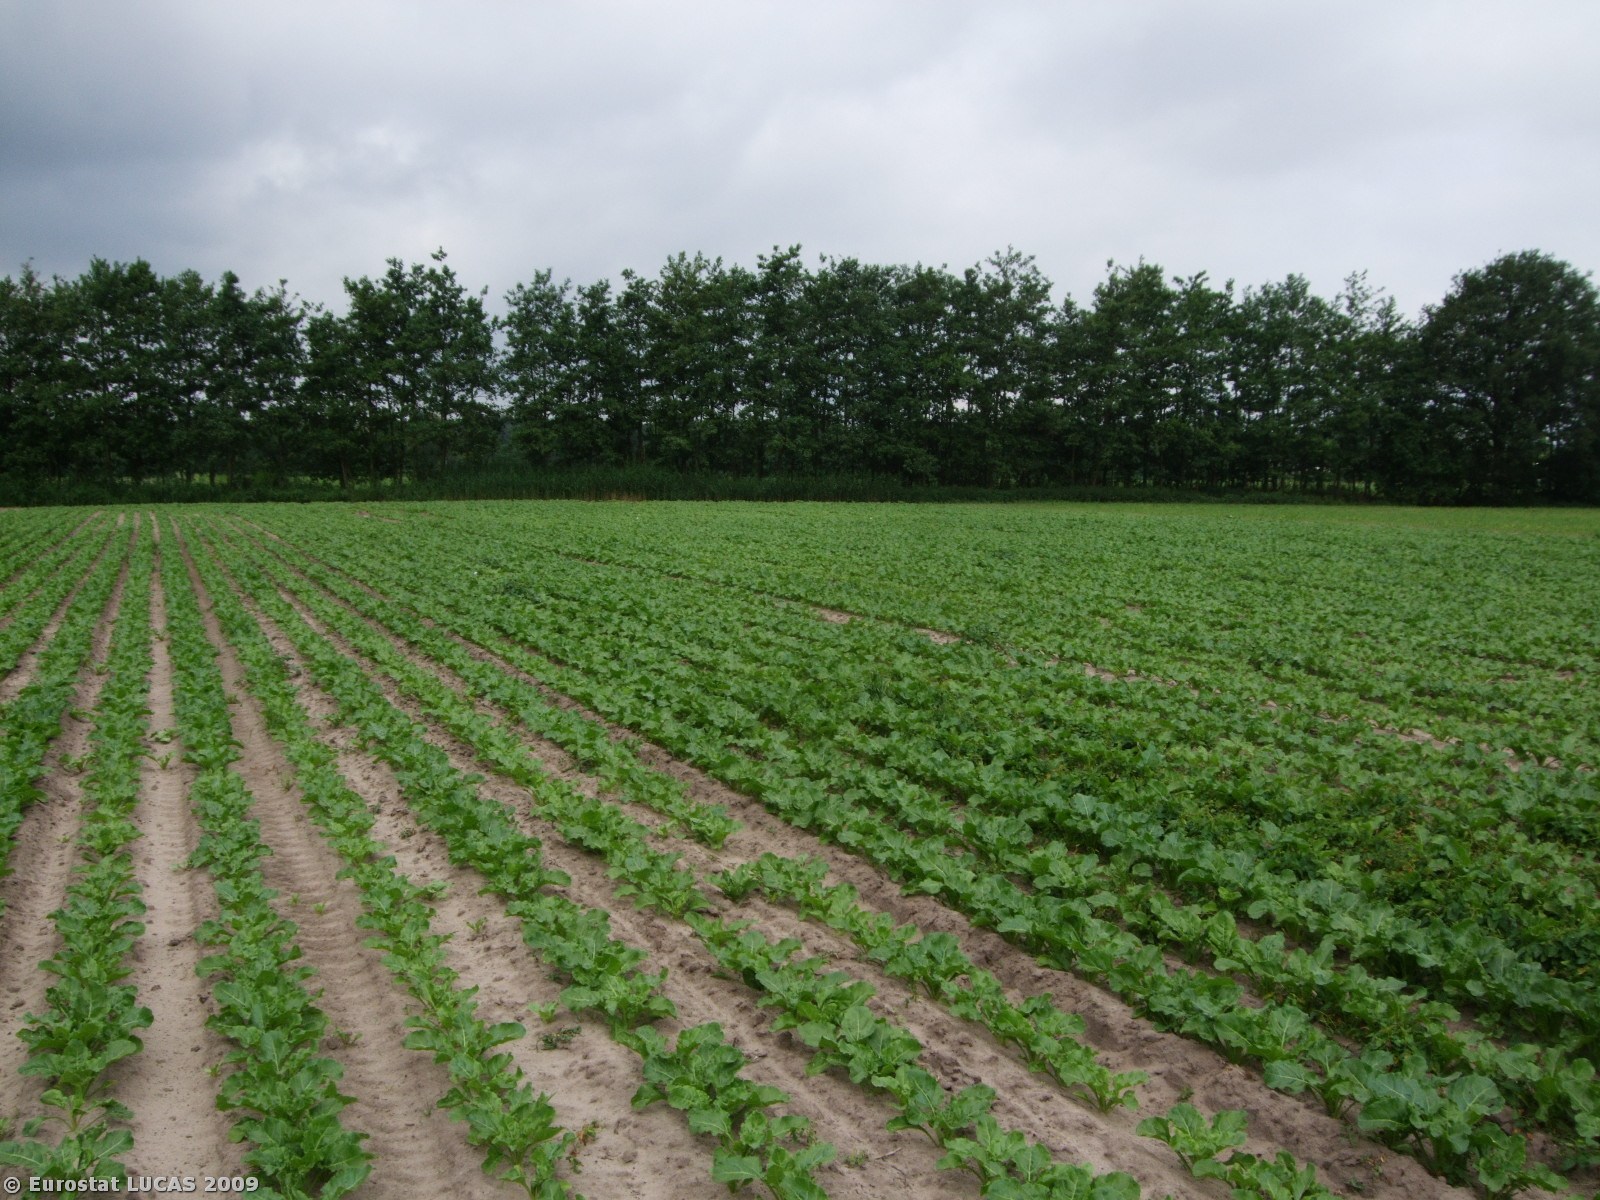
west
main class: Cropland
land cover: Sugar beet
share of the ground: 50 - 75 %
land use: Agriculture (excluding fallow land and kitchen gardens)
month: May
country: NL
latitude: 51.7137
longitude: 5.4390
